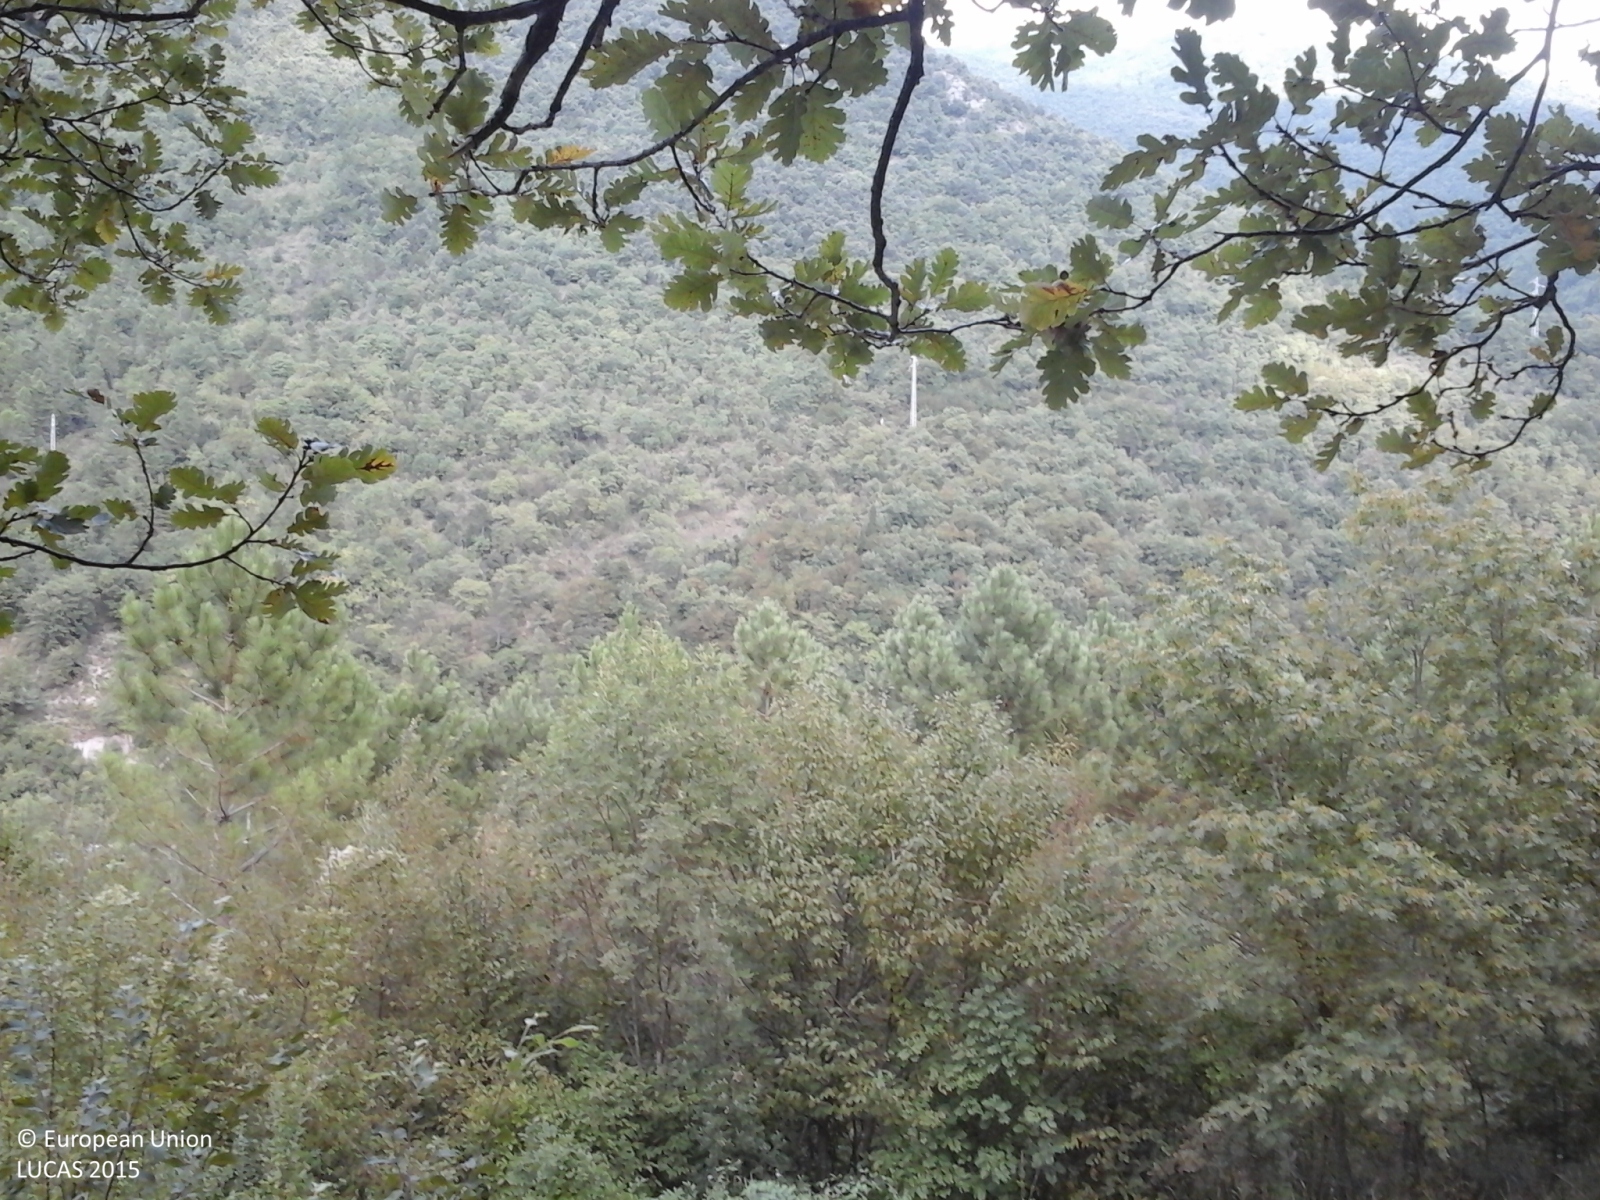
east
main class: Woodland
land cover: Broadleaved woodland
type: thermophilous deciduous forest
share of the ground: > 75 %
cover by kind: broadleaved forest trees 95 %, shrubs 5 %
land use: Forestry
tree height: > 5 m
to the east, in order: Broadleaved woodland; Inland fresh running water; Broadleaved woodland; Tracks; Broadleaved woodland; Paved roads, cycling and walking lanes; Broadleaved woodland; Paved roads, cycling and walking lanes; Broadleaved woodland; Electric lines; Broadleaved woodland
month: August
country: IT
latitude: 43.3687
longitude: 12.9910
